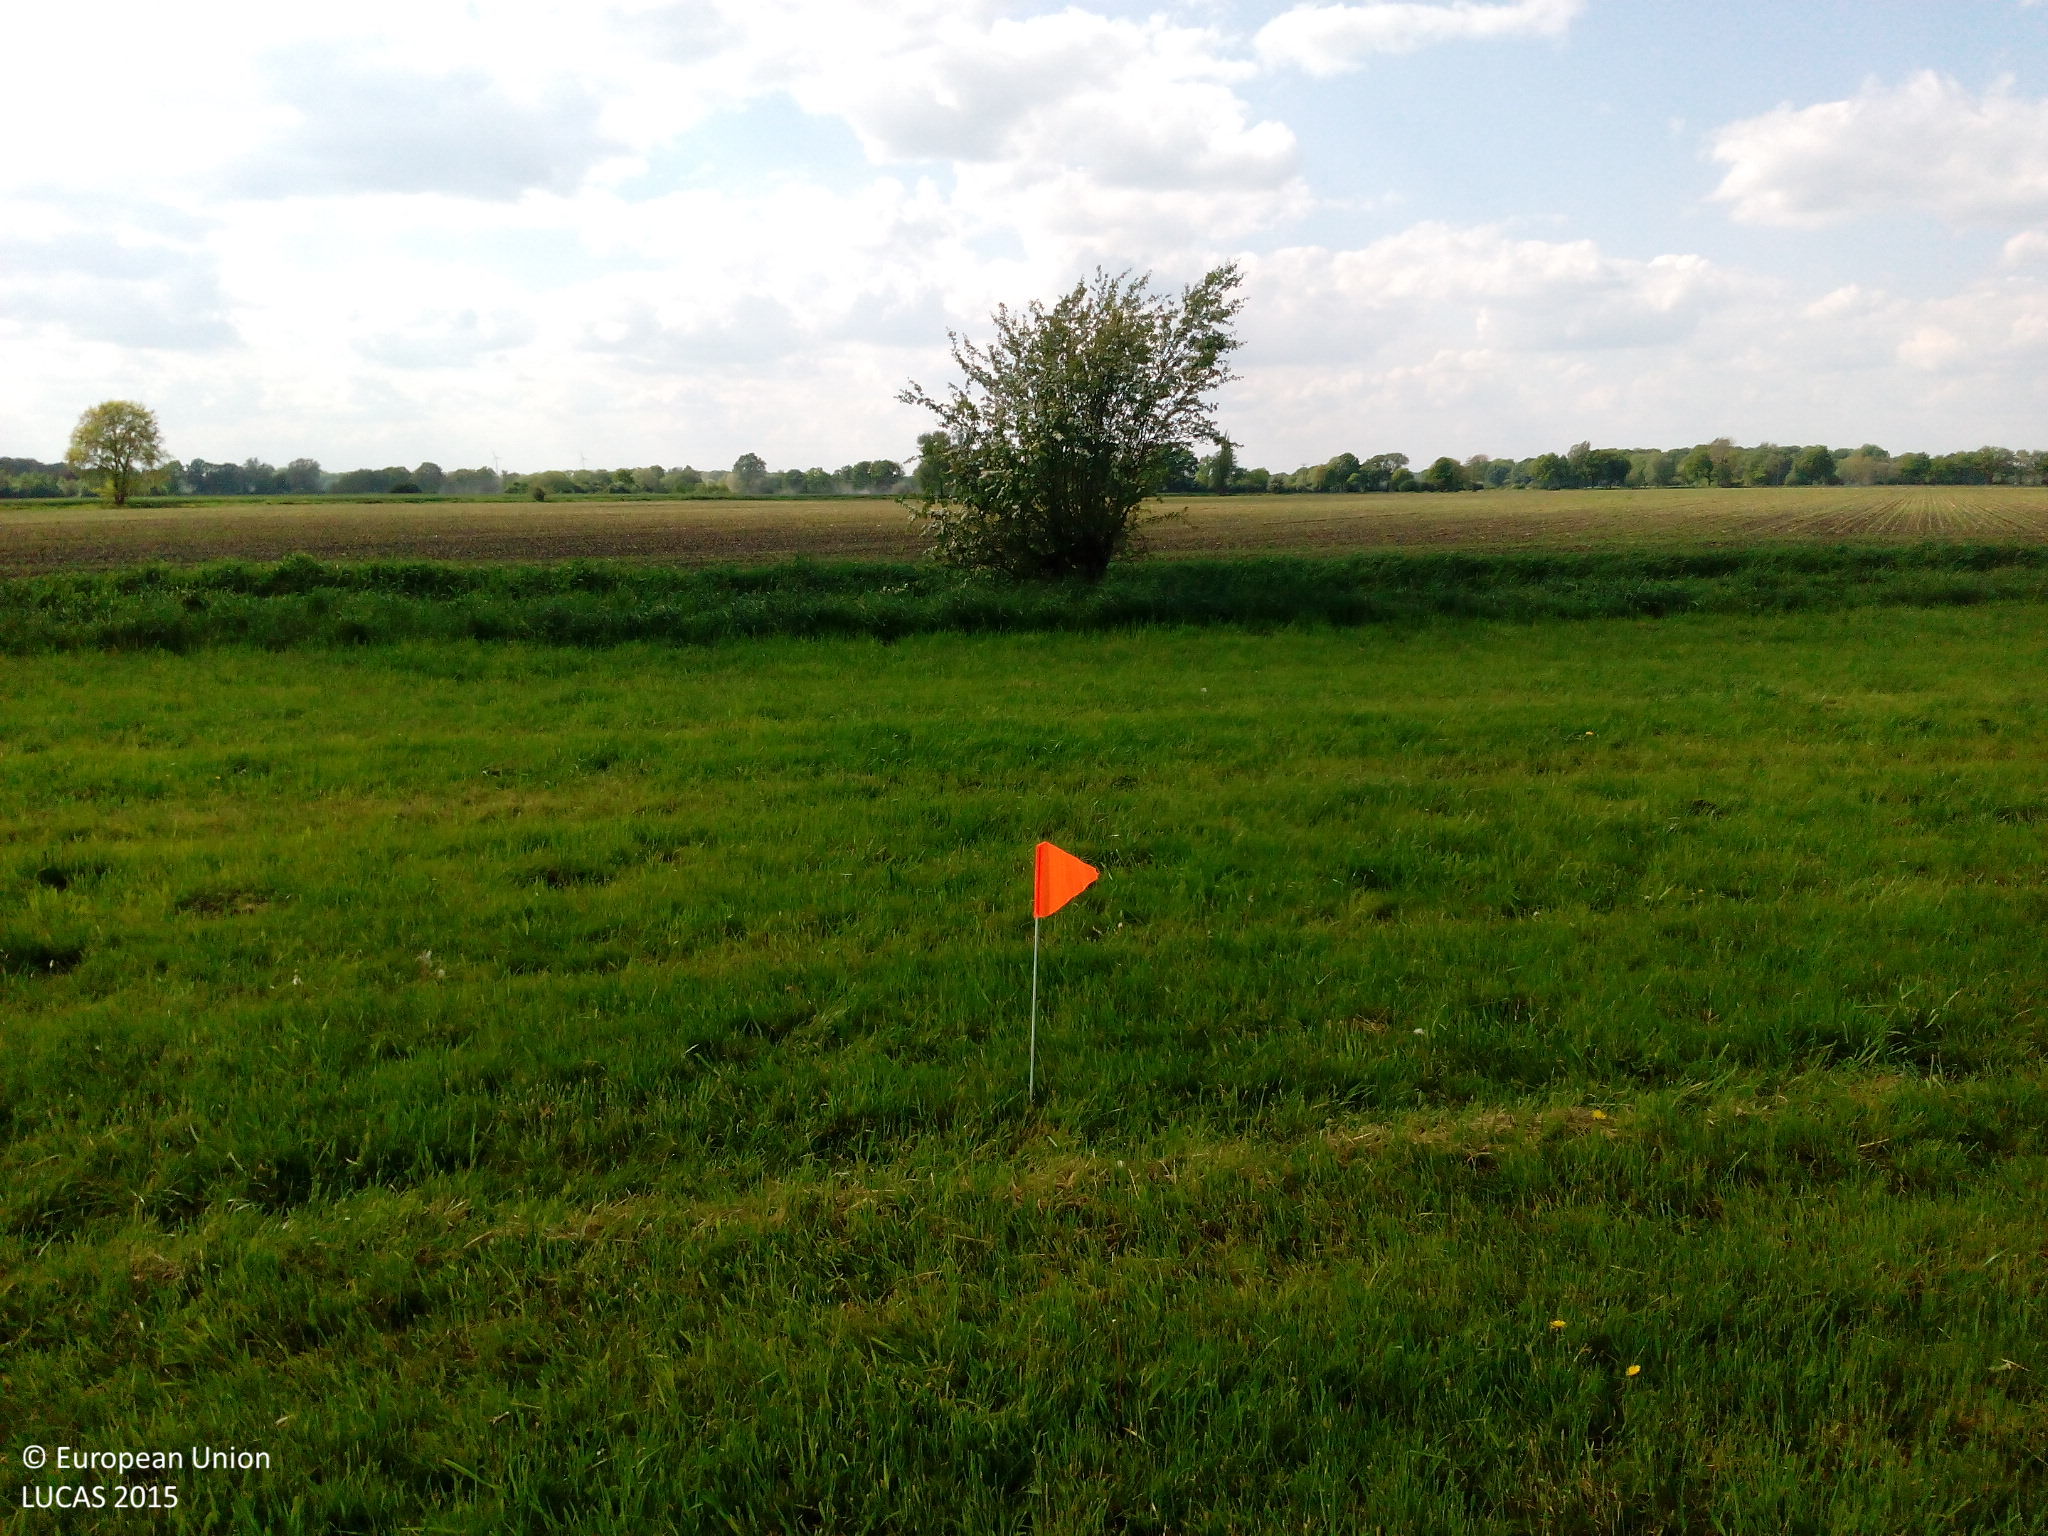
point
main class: Grassland
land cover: Grassland without tree/shrub cover
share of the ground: > 75 %
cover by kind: herbaceous plants 95 %, unconsolidated bare surface 5 %
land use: Agriculture (excluding fallow land and kitchen gardens)
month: May
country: DE
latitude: 52.8224
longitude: 11.0236
